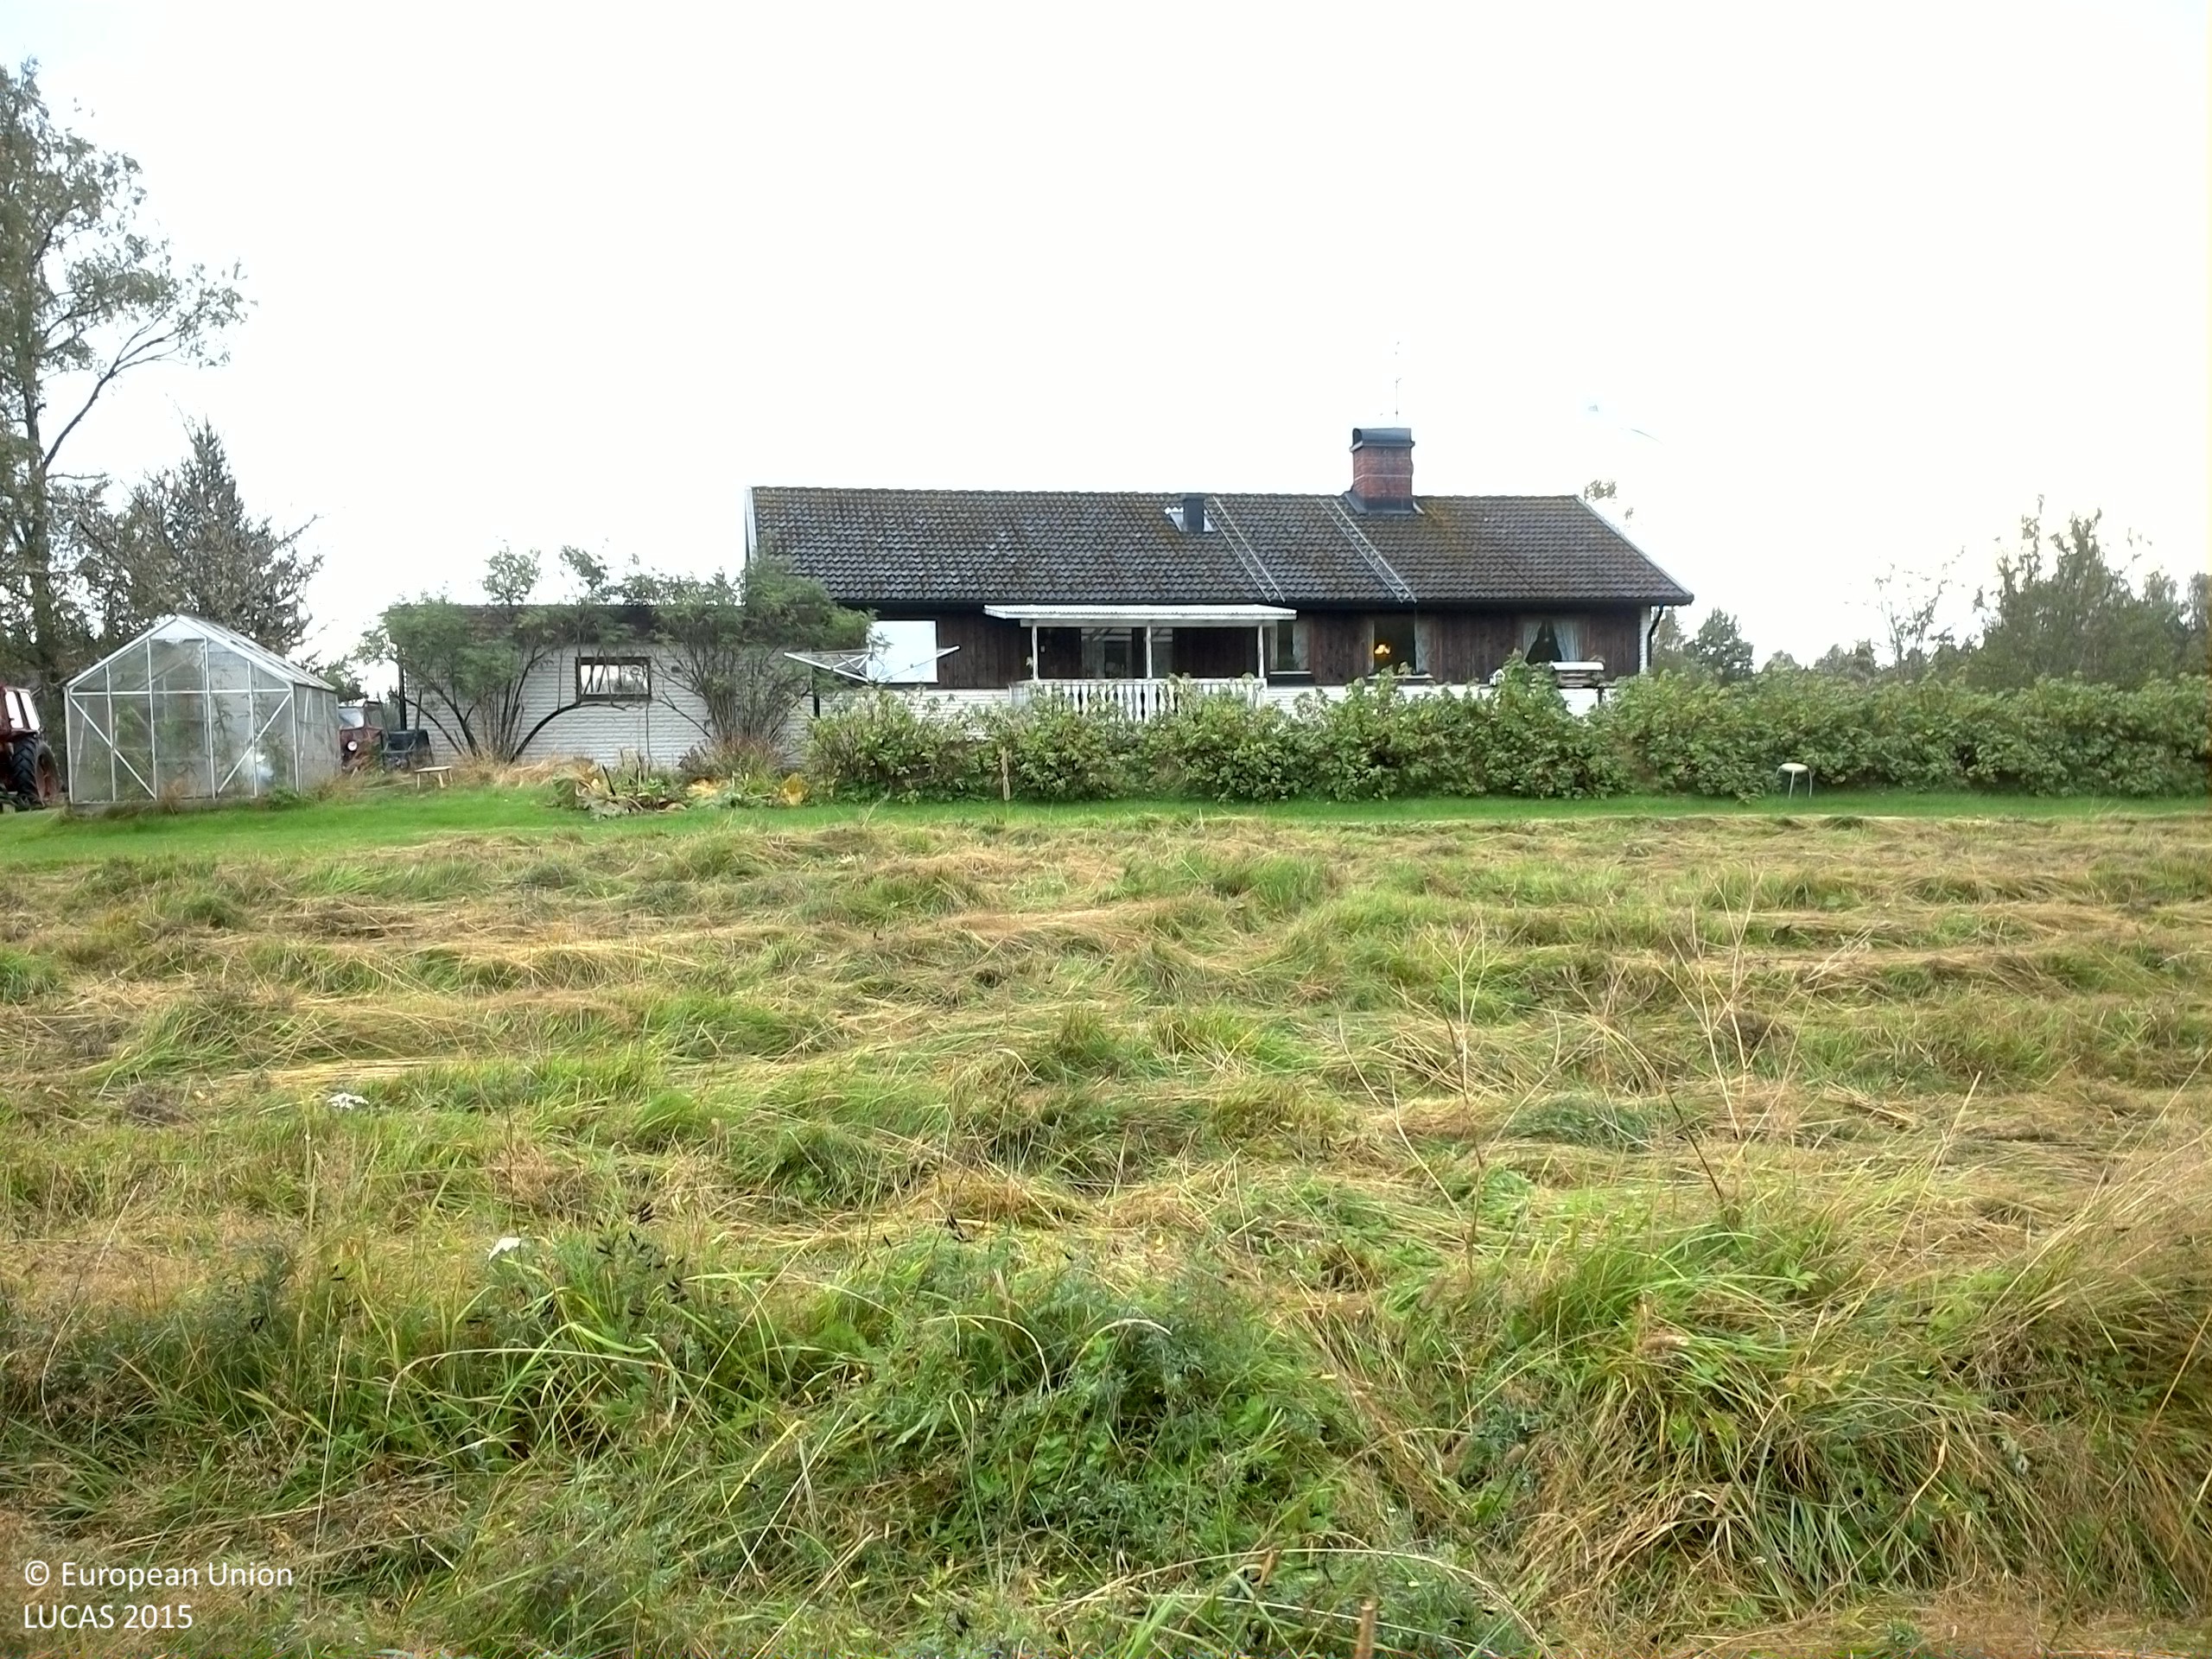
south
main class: Grassland
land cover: Grassland without tree/shrub cover
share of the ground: > 75 %
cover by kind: herbaceous plants 90 %, consolidated bare surface 10 %
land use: Agriculture (excluding fallow land and kitchen gardens)
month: September
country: SE
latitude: 59.3517
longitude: 12.2982
